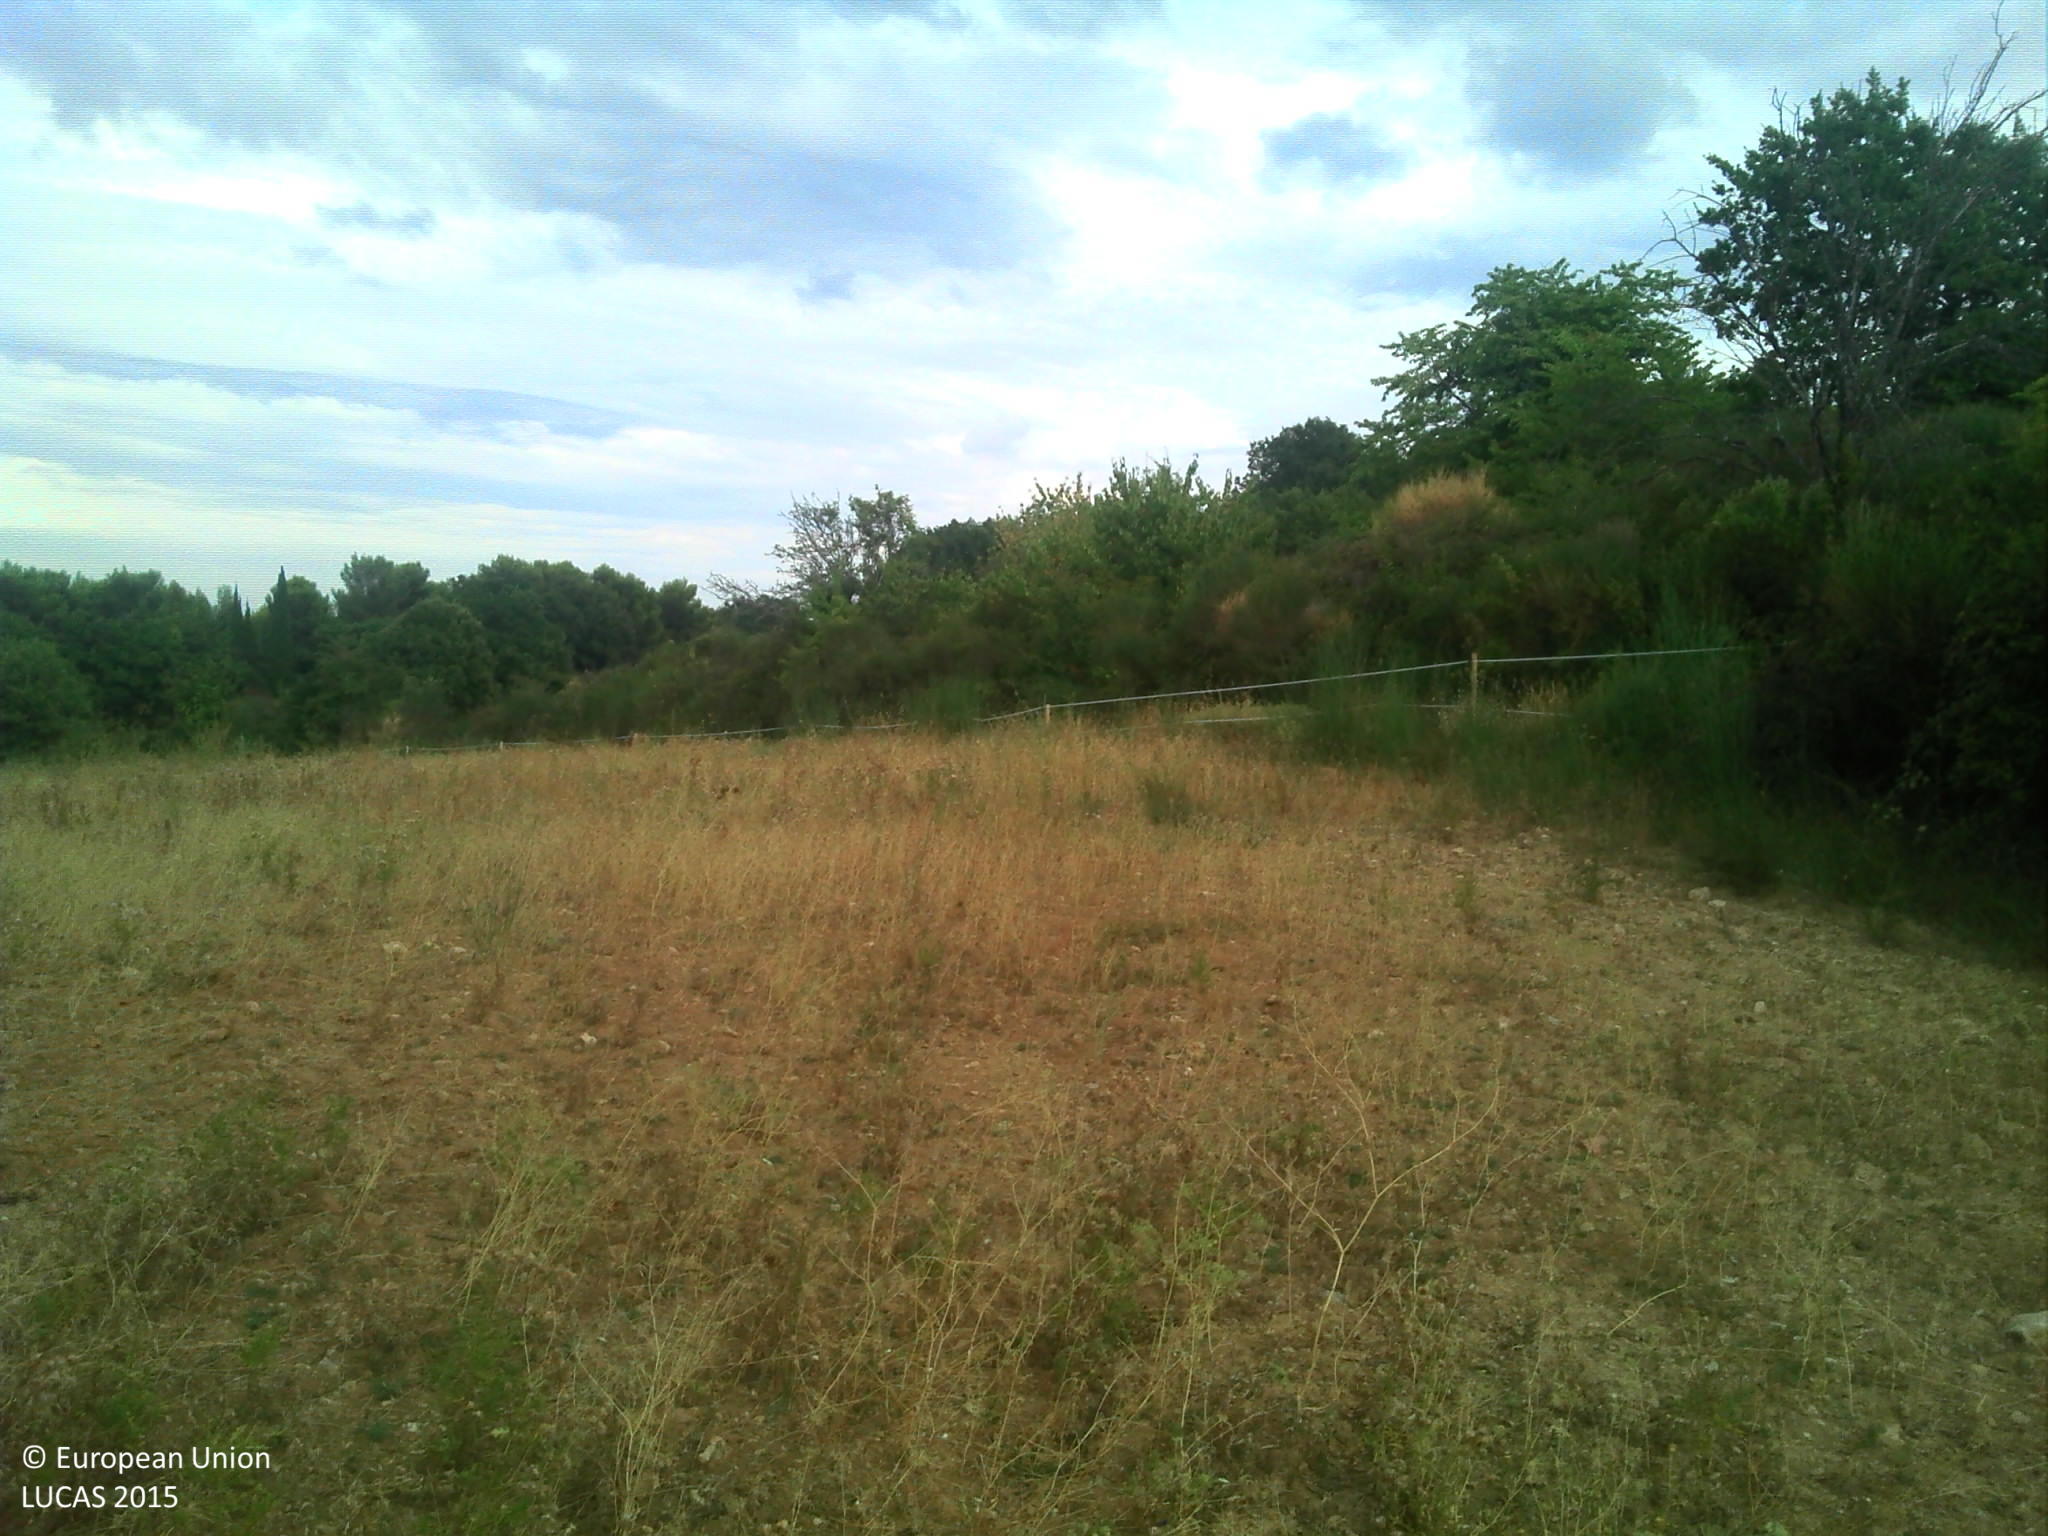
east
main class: Grassland
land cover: Spontaneously vegetated surfaces
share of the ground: 25 - 50 %
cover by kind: unconsolidated bare surface 55 %, herbaceous plants 45 %
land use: Fallow land
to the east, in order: Spontaneously vegetated surfaces; Fences; Grass margins; Tracks; Broadleaved woodland; Grassland without tree/shrub cover; Broadleaved woodland; Pine dominated mixed woodland; Tracks; Pine dominated mixed woodland
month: August
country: FR
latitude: 43.4209
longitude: 5.4770
